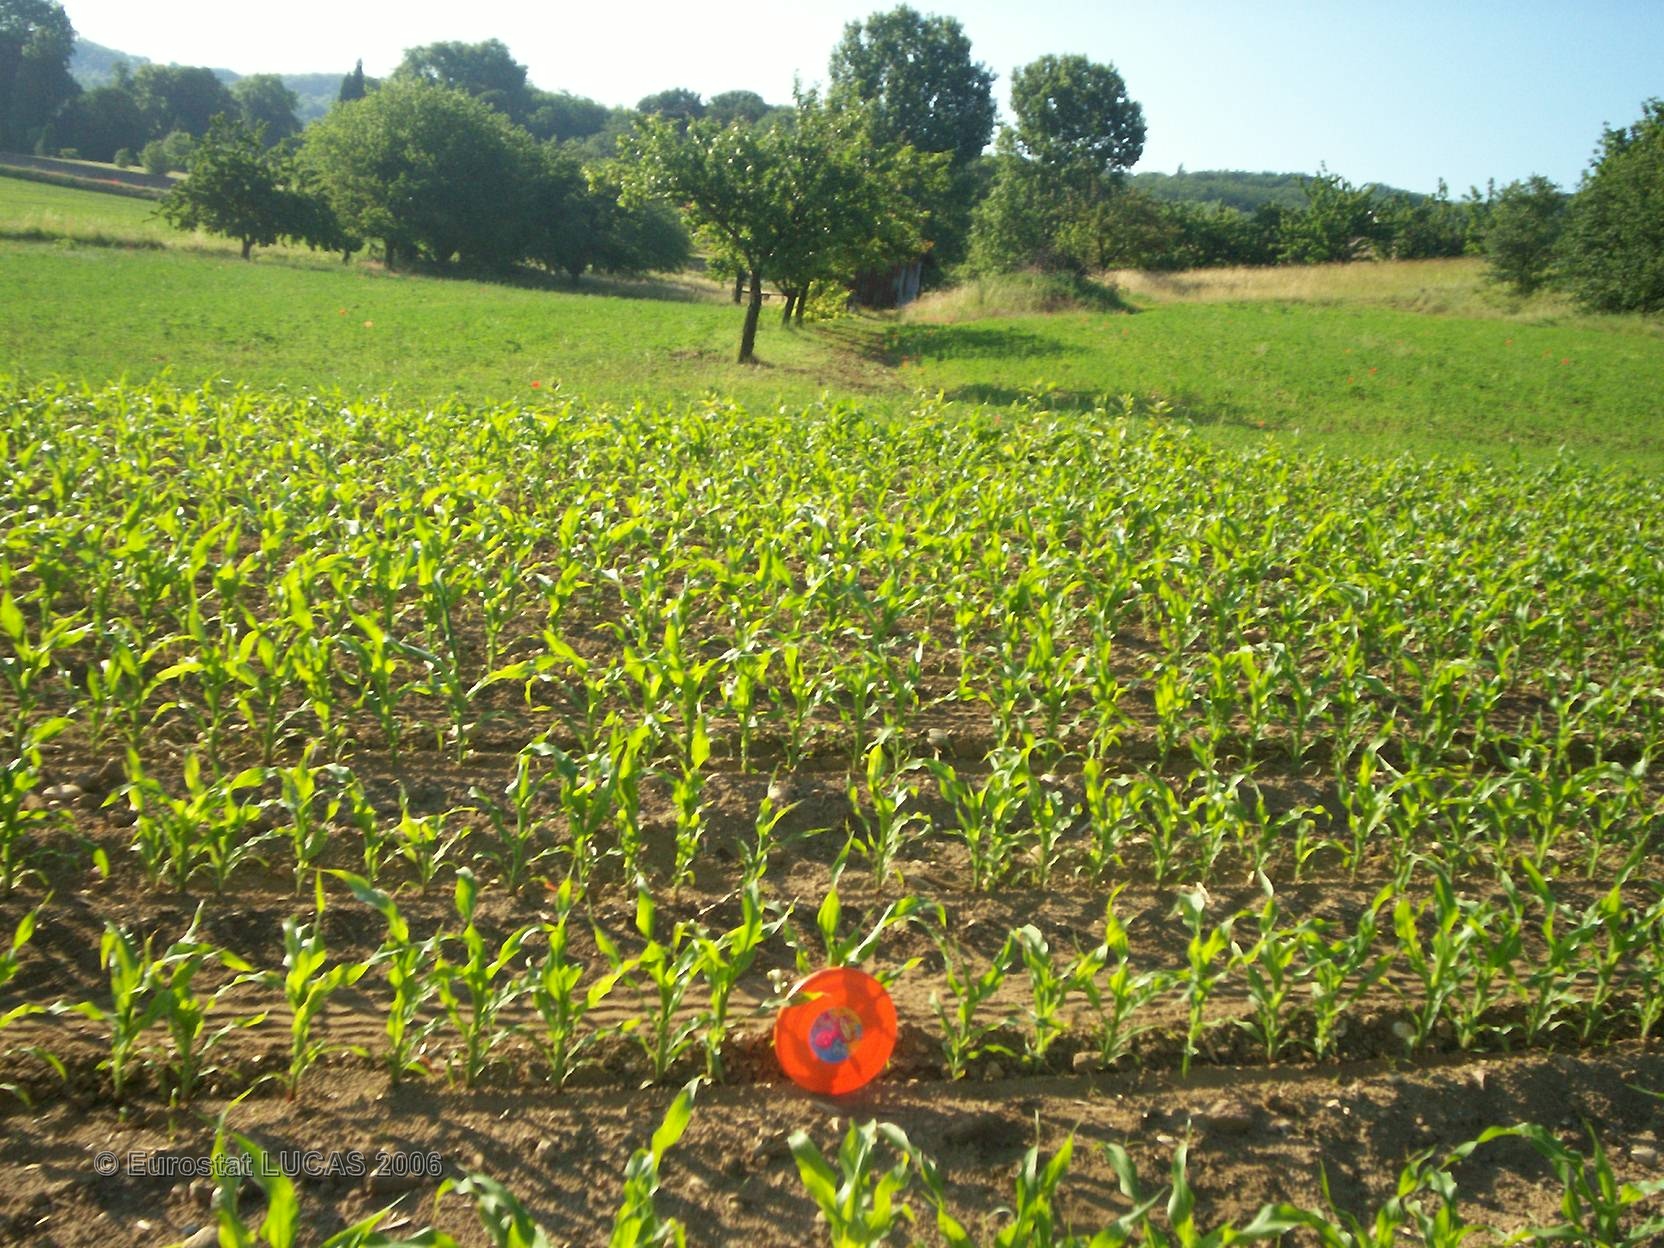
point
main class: Cropland
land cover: Maize
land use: Agriculture (excluding fallow land and kitchen gardens)
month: June
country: FR
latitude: 45.2149
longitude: 4.8224
